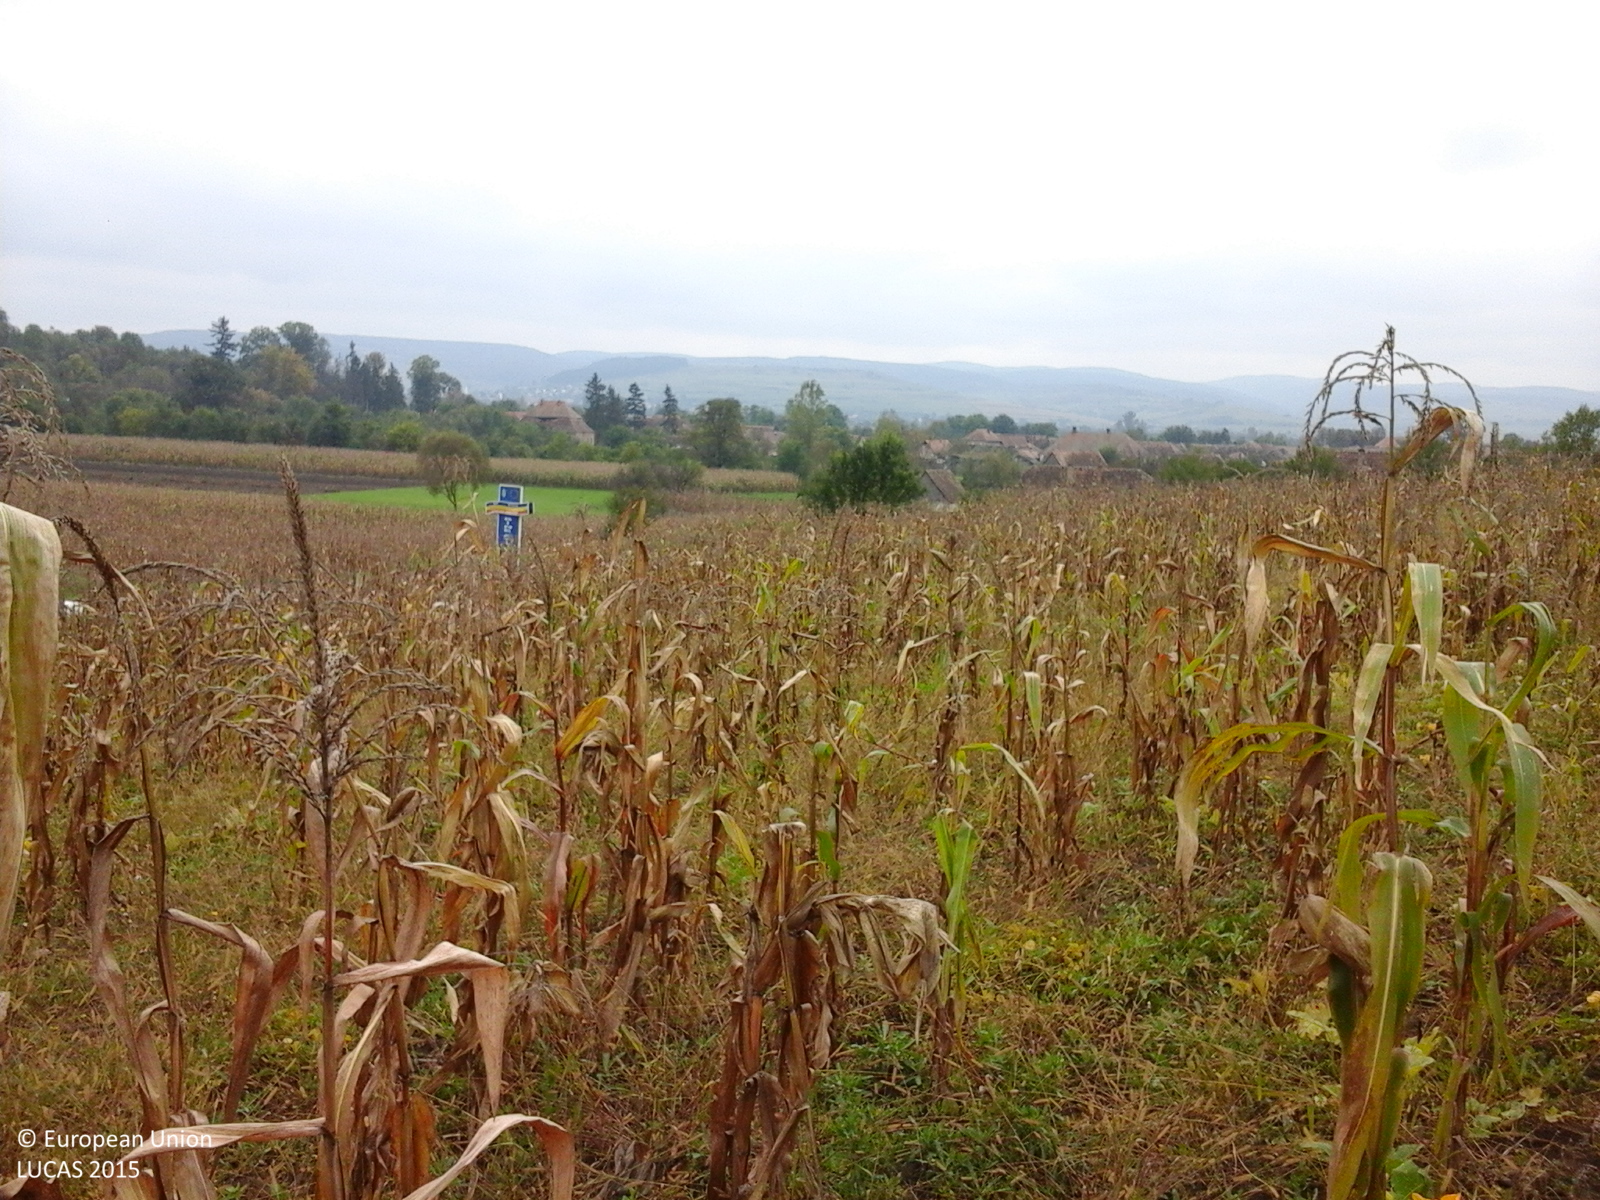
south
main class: Cropland
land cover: Maize
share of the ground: 25 - 50 %
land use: Agriculture (excluding fallow land and kitchen gardens)
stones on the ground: < 10 %
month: October
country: RO
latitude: 46.2669
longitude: 24.9244
